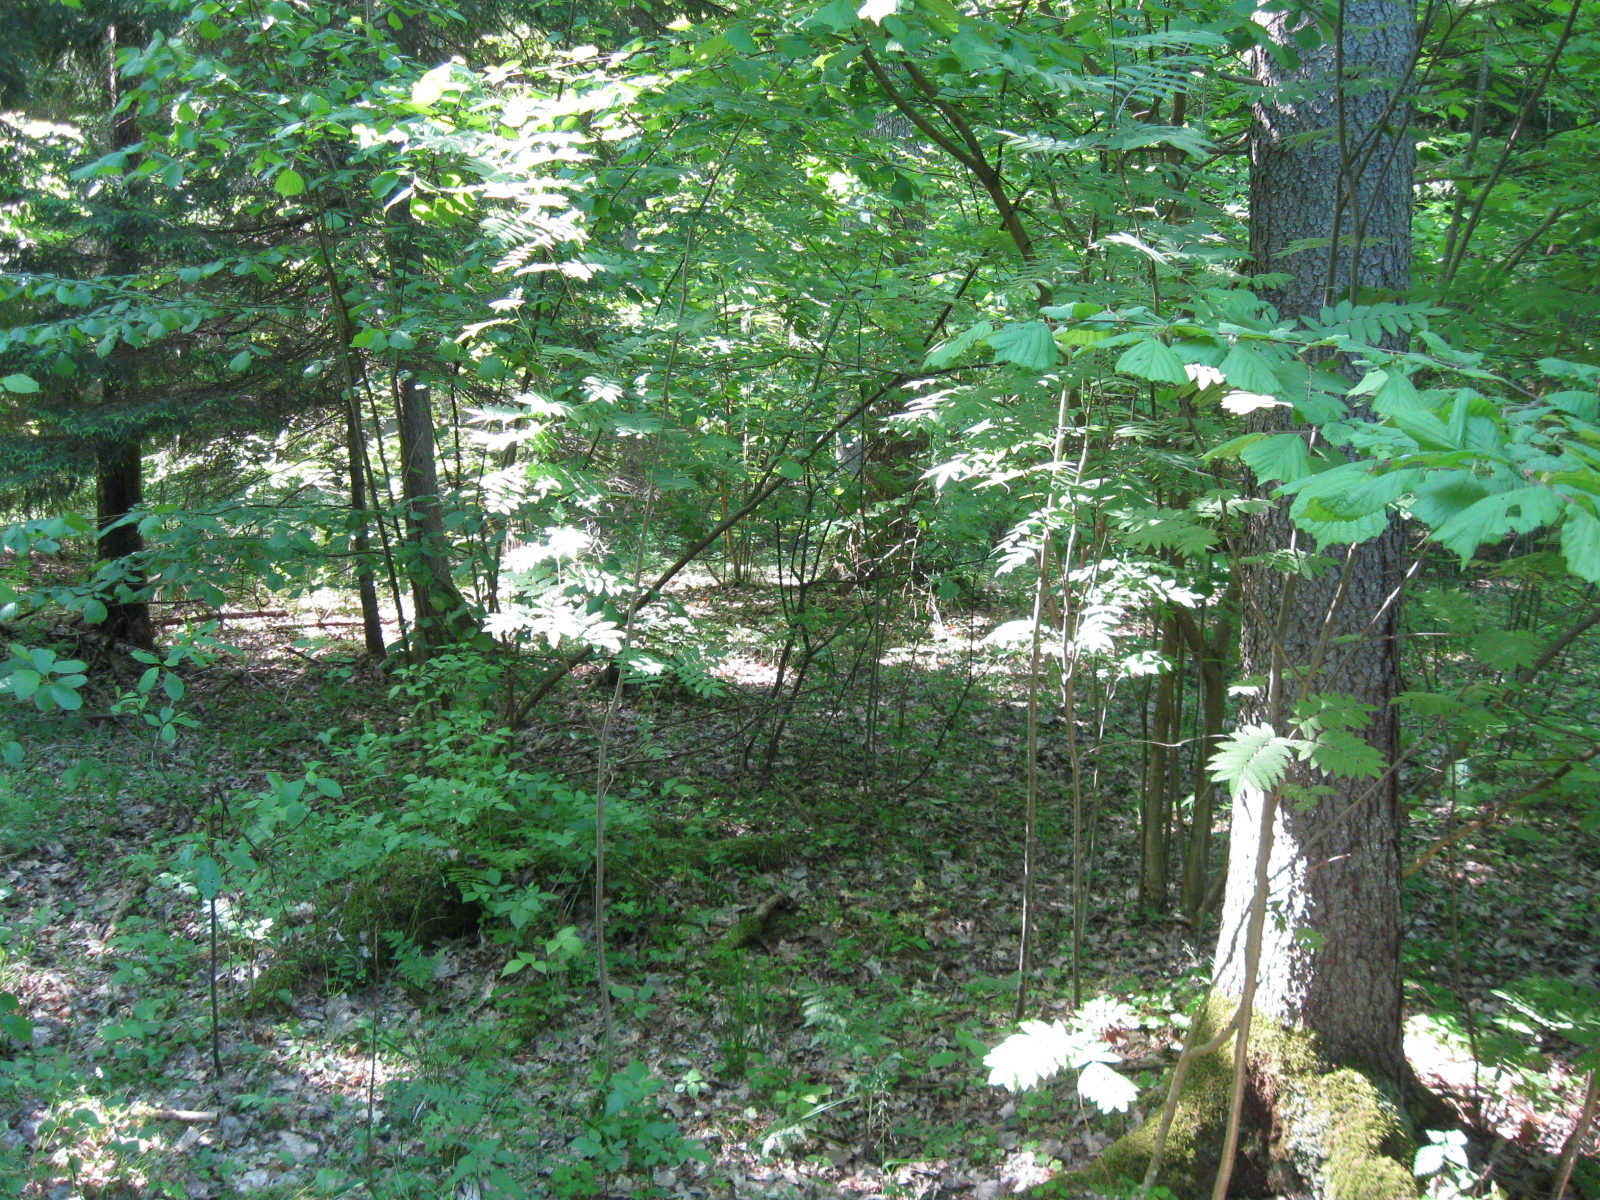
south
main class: Woodland
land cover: Spruce dominated mixed woodland
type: hemiboreal forest and nemoral coniferous forest and mixed broadleaved-coniferous forest
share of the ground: > 75 %
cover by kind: broadleaved forest trees 55 %, coniferous forest trees 40 %, herbaceous plants 5 %
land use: Forestry
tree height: > 5 m
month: June
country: LT
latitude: 54.5565
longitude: 23.8349
